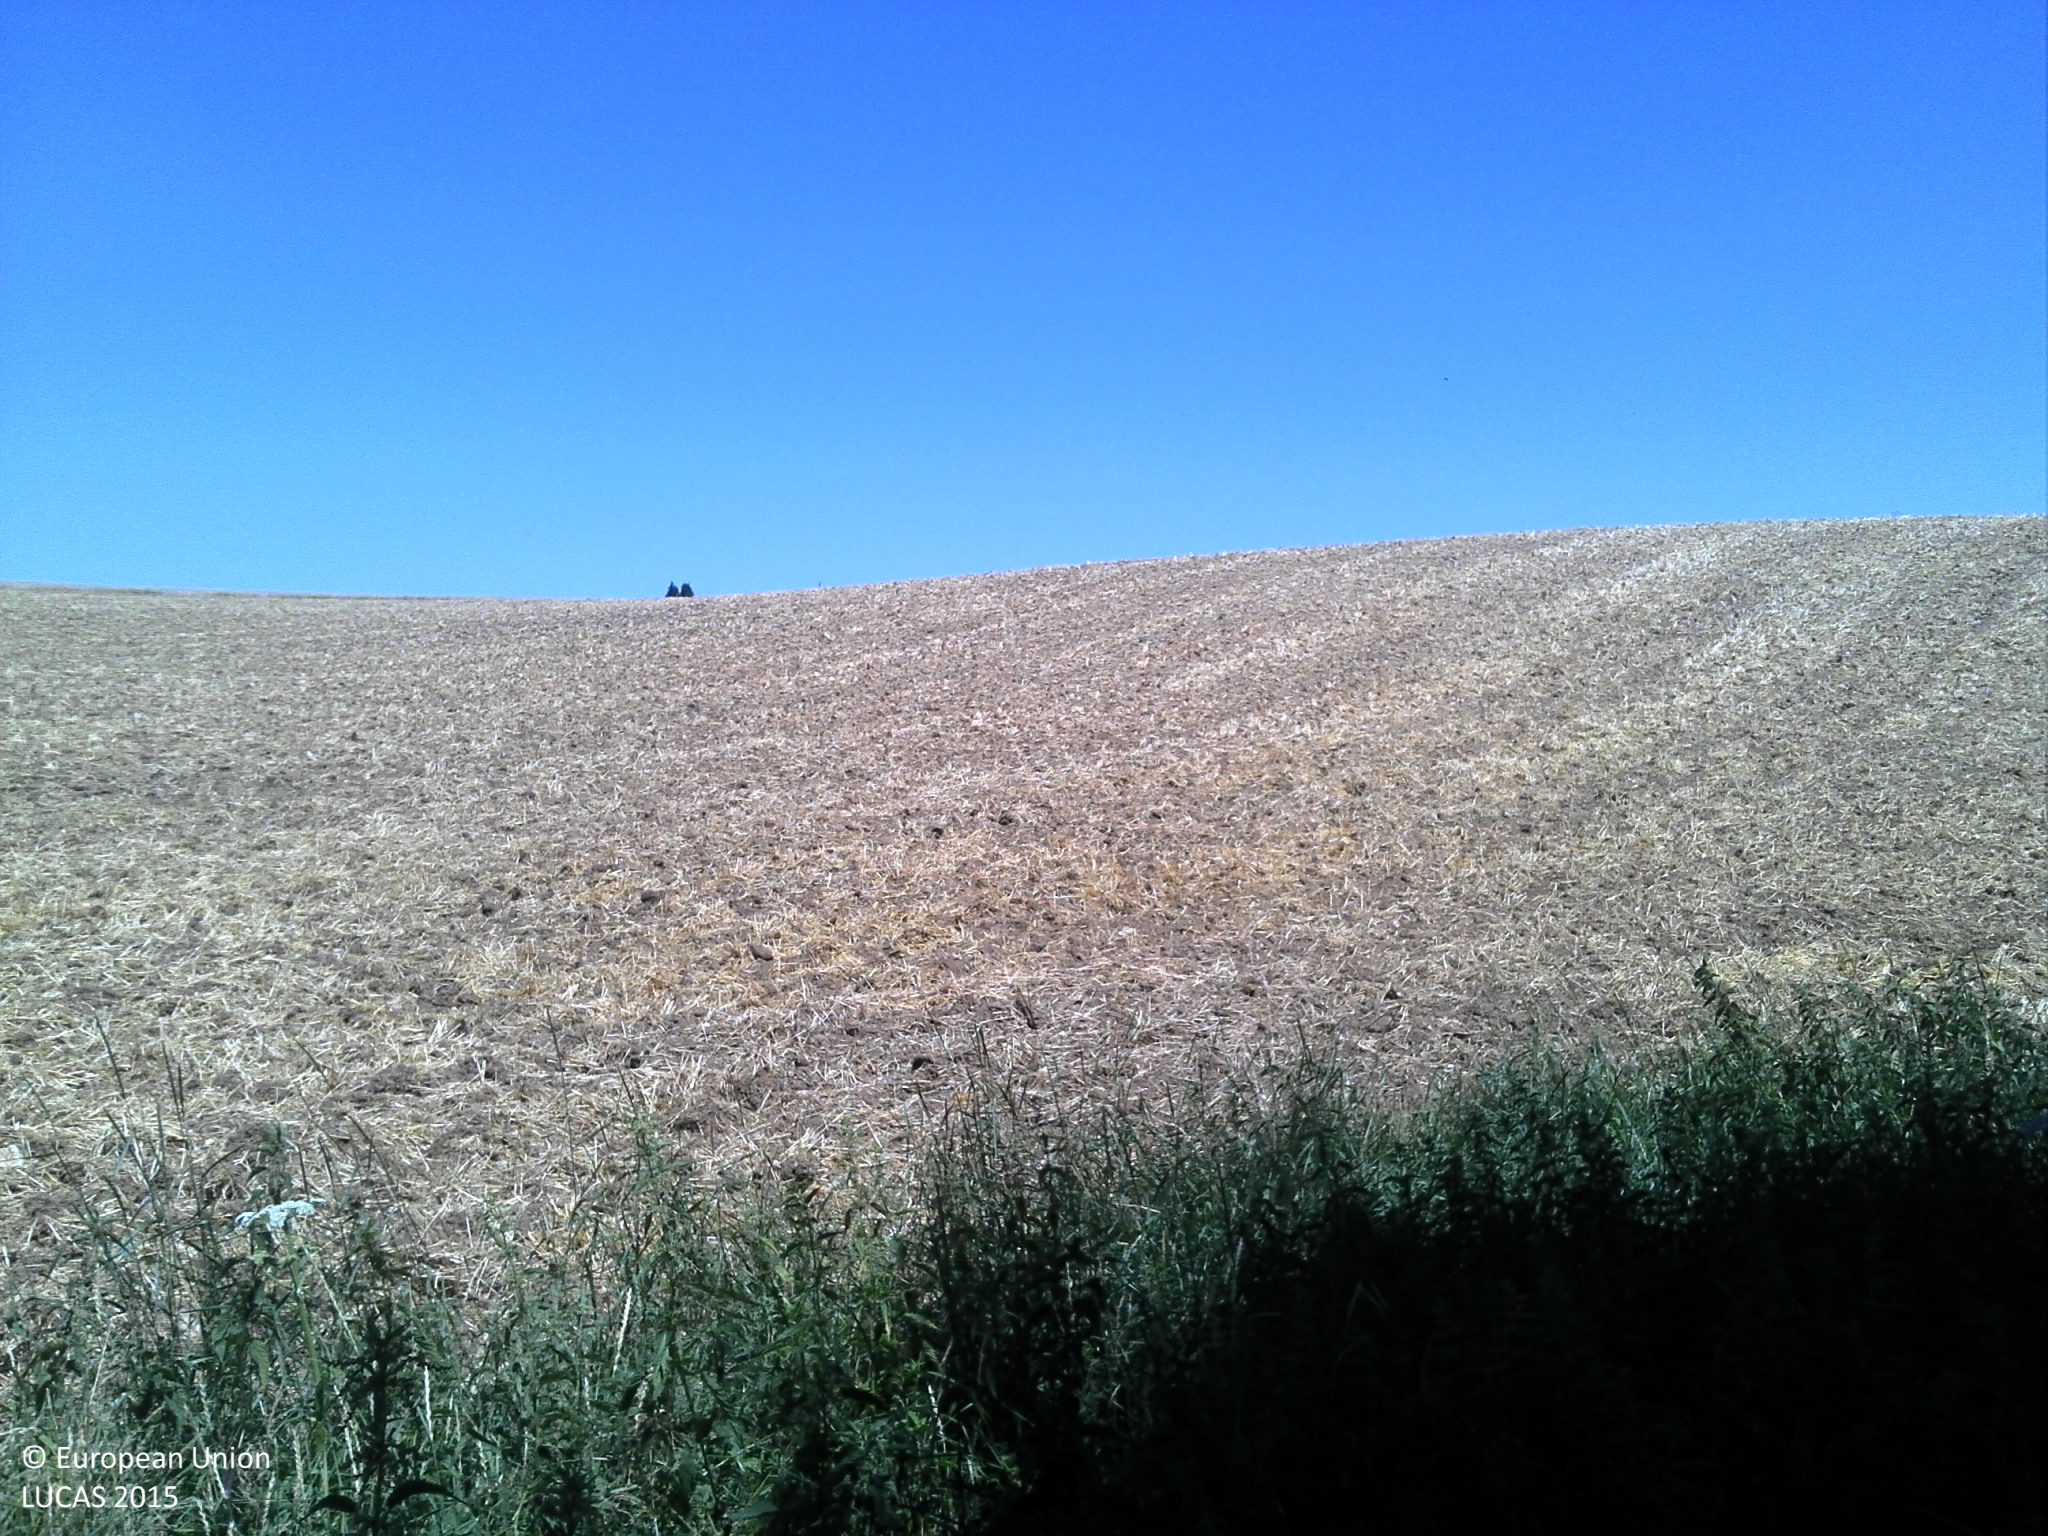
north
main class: Grassland
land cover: Grassland without tree/shrub cover
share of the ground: > 75 %
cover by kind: herbaceous plants 100 %
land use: Agriculture (excluding fallow land and kitchen gardens)
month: July
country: FR
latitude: 49.5718
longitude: 4.6451
